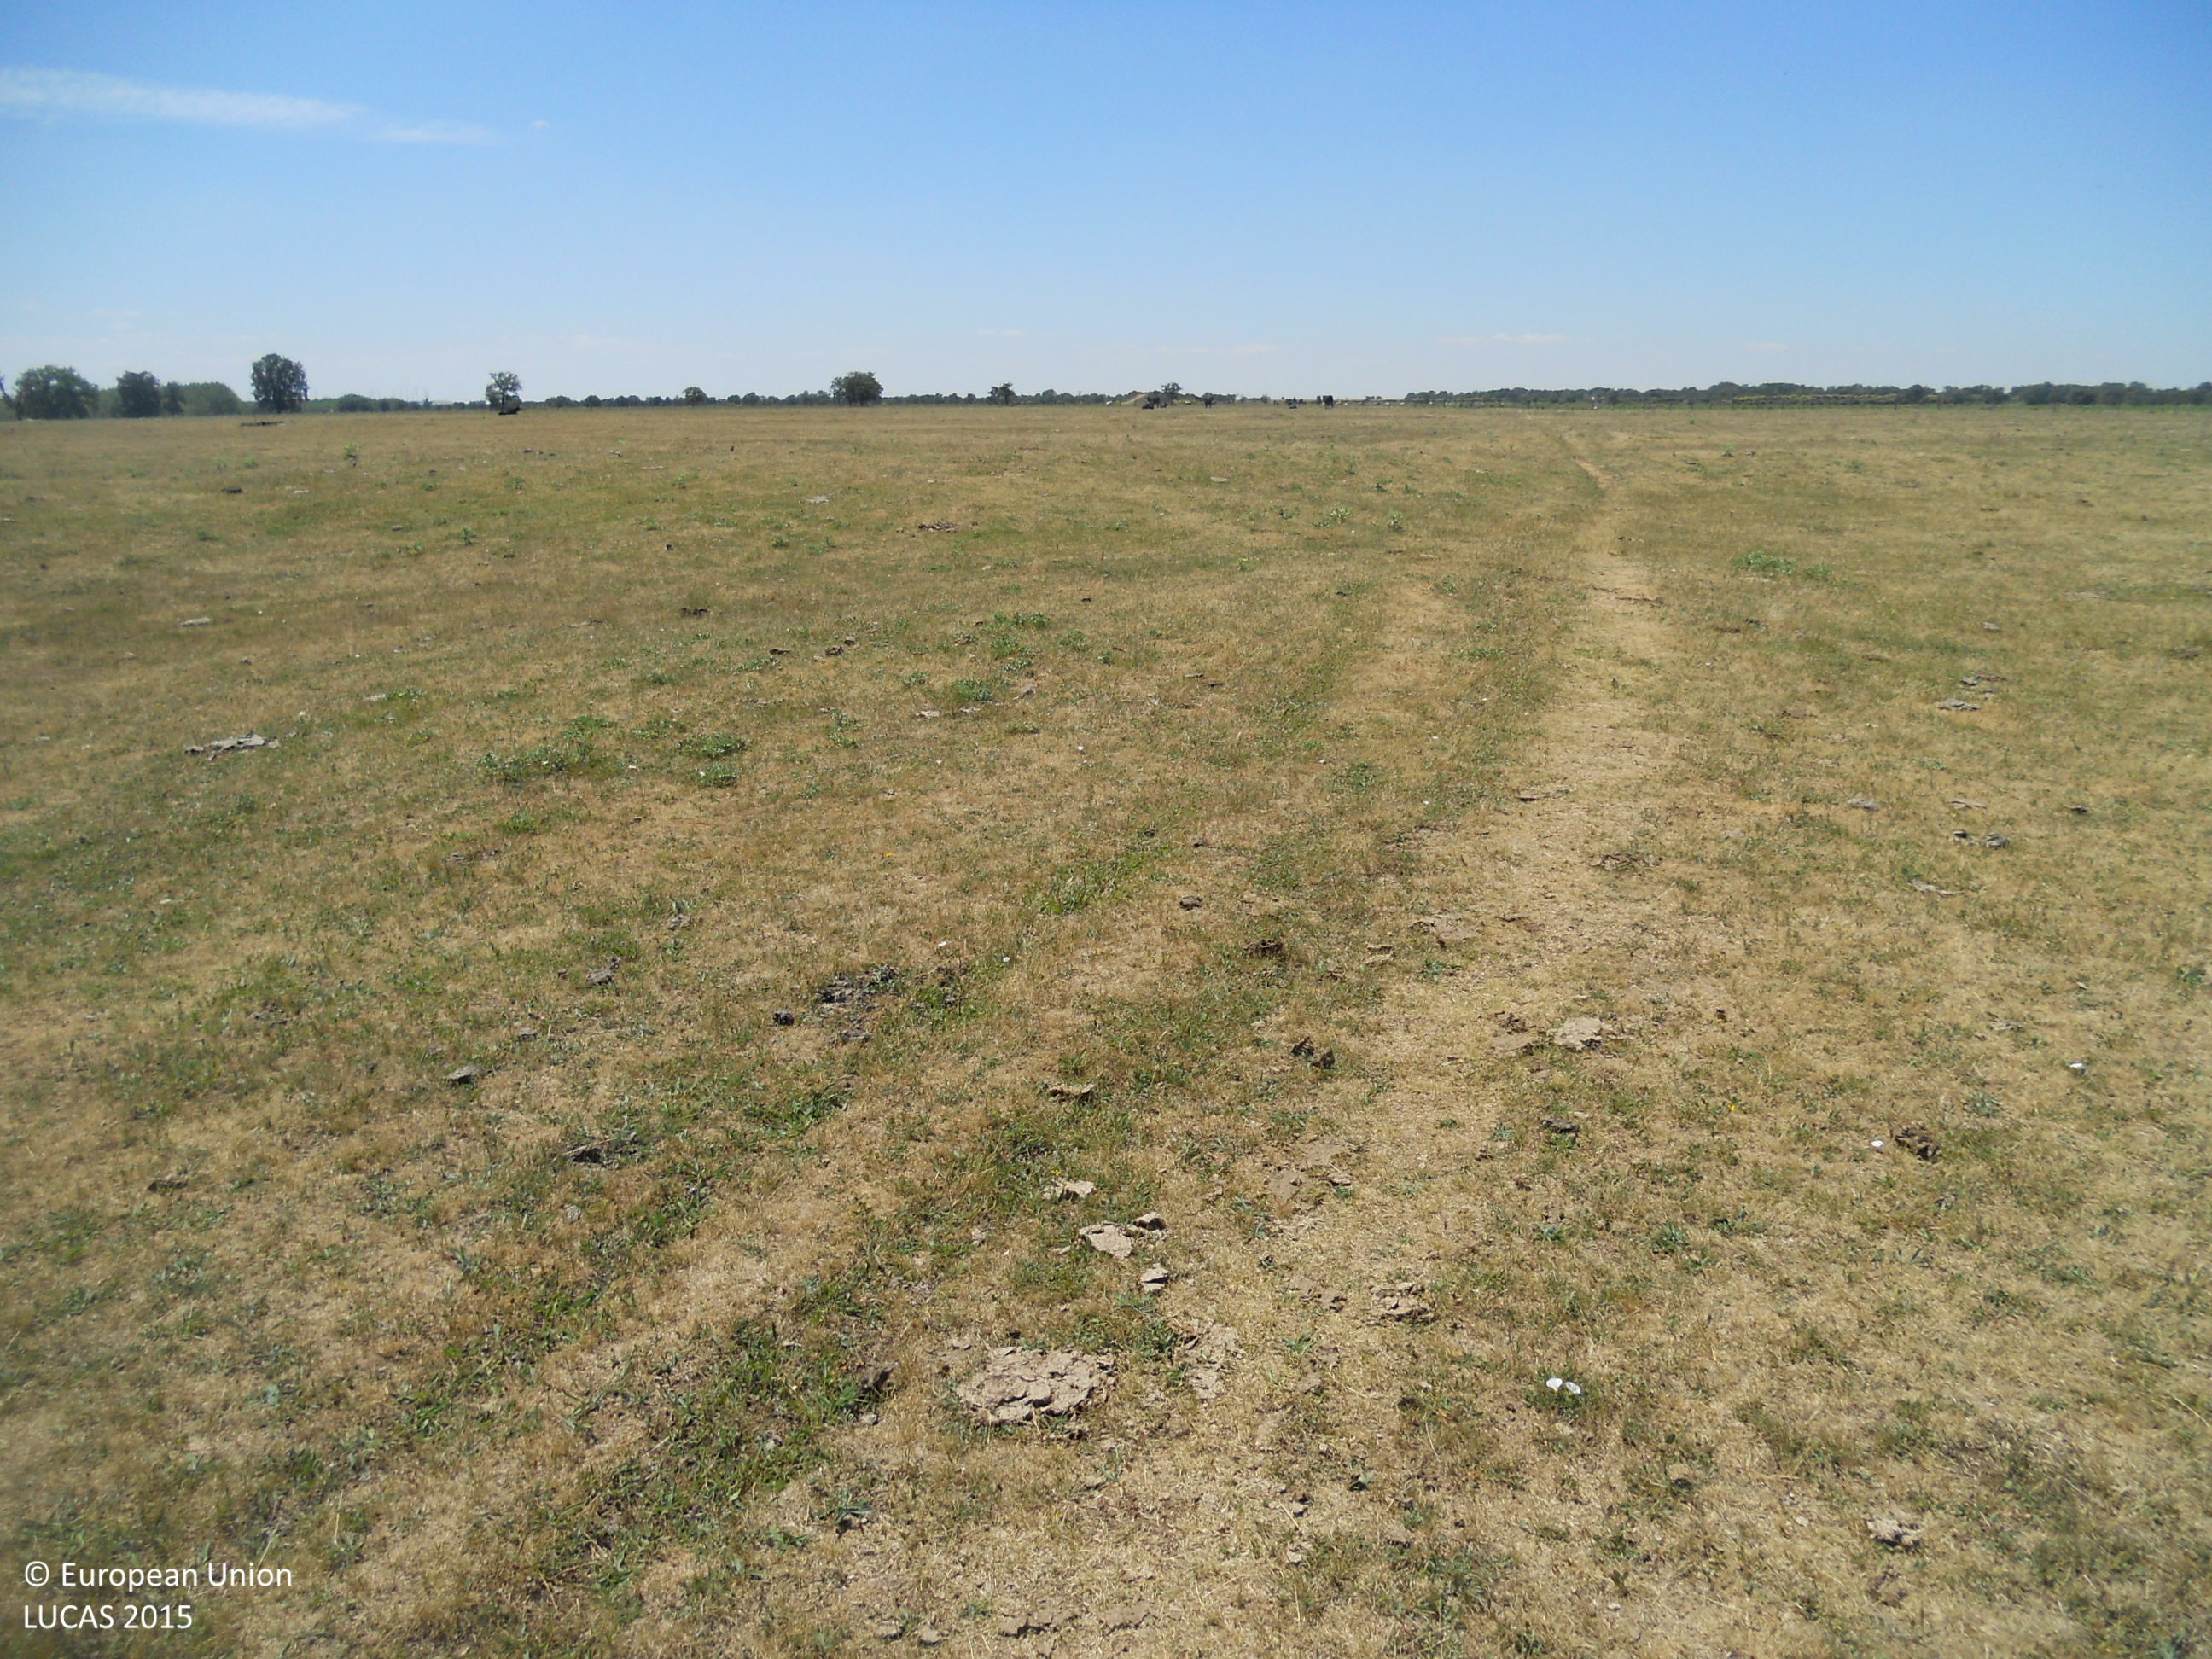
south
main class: Grassland
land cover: Grassland without tree/shrub cover
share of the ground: > 75 %
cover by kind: herbaceous plants 100 %
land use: Agriculture (excluding fallow land and kitchen gardens)
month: June
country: ES
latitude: 42.3687
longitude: -4.7843
